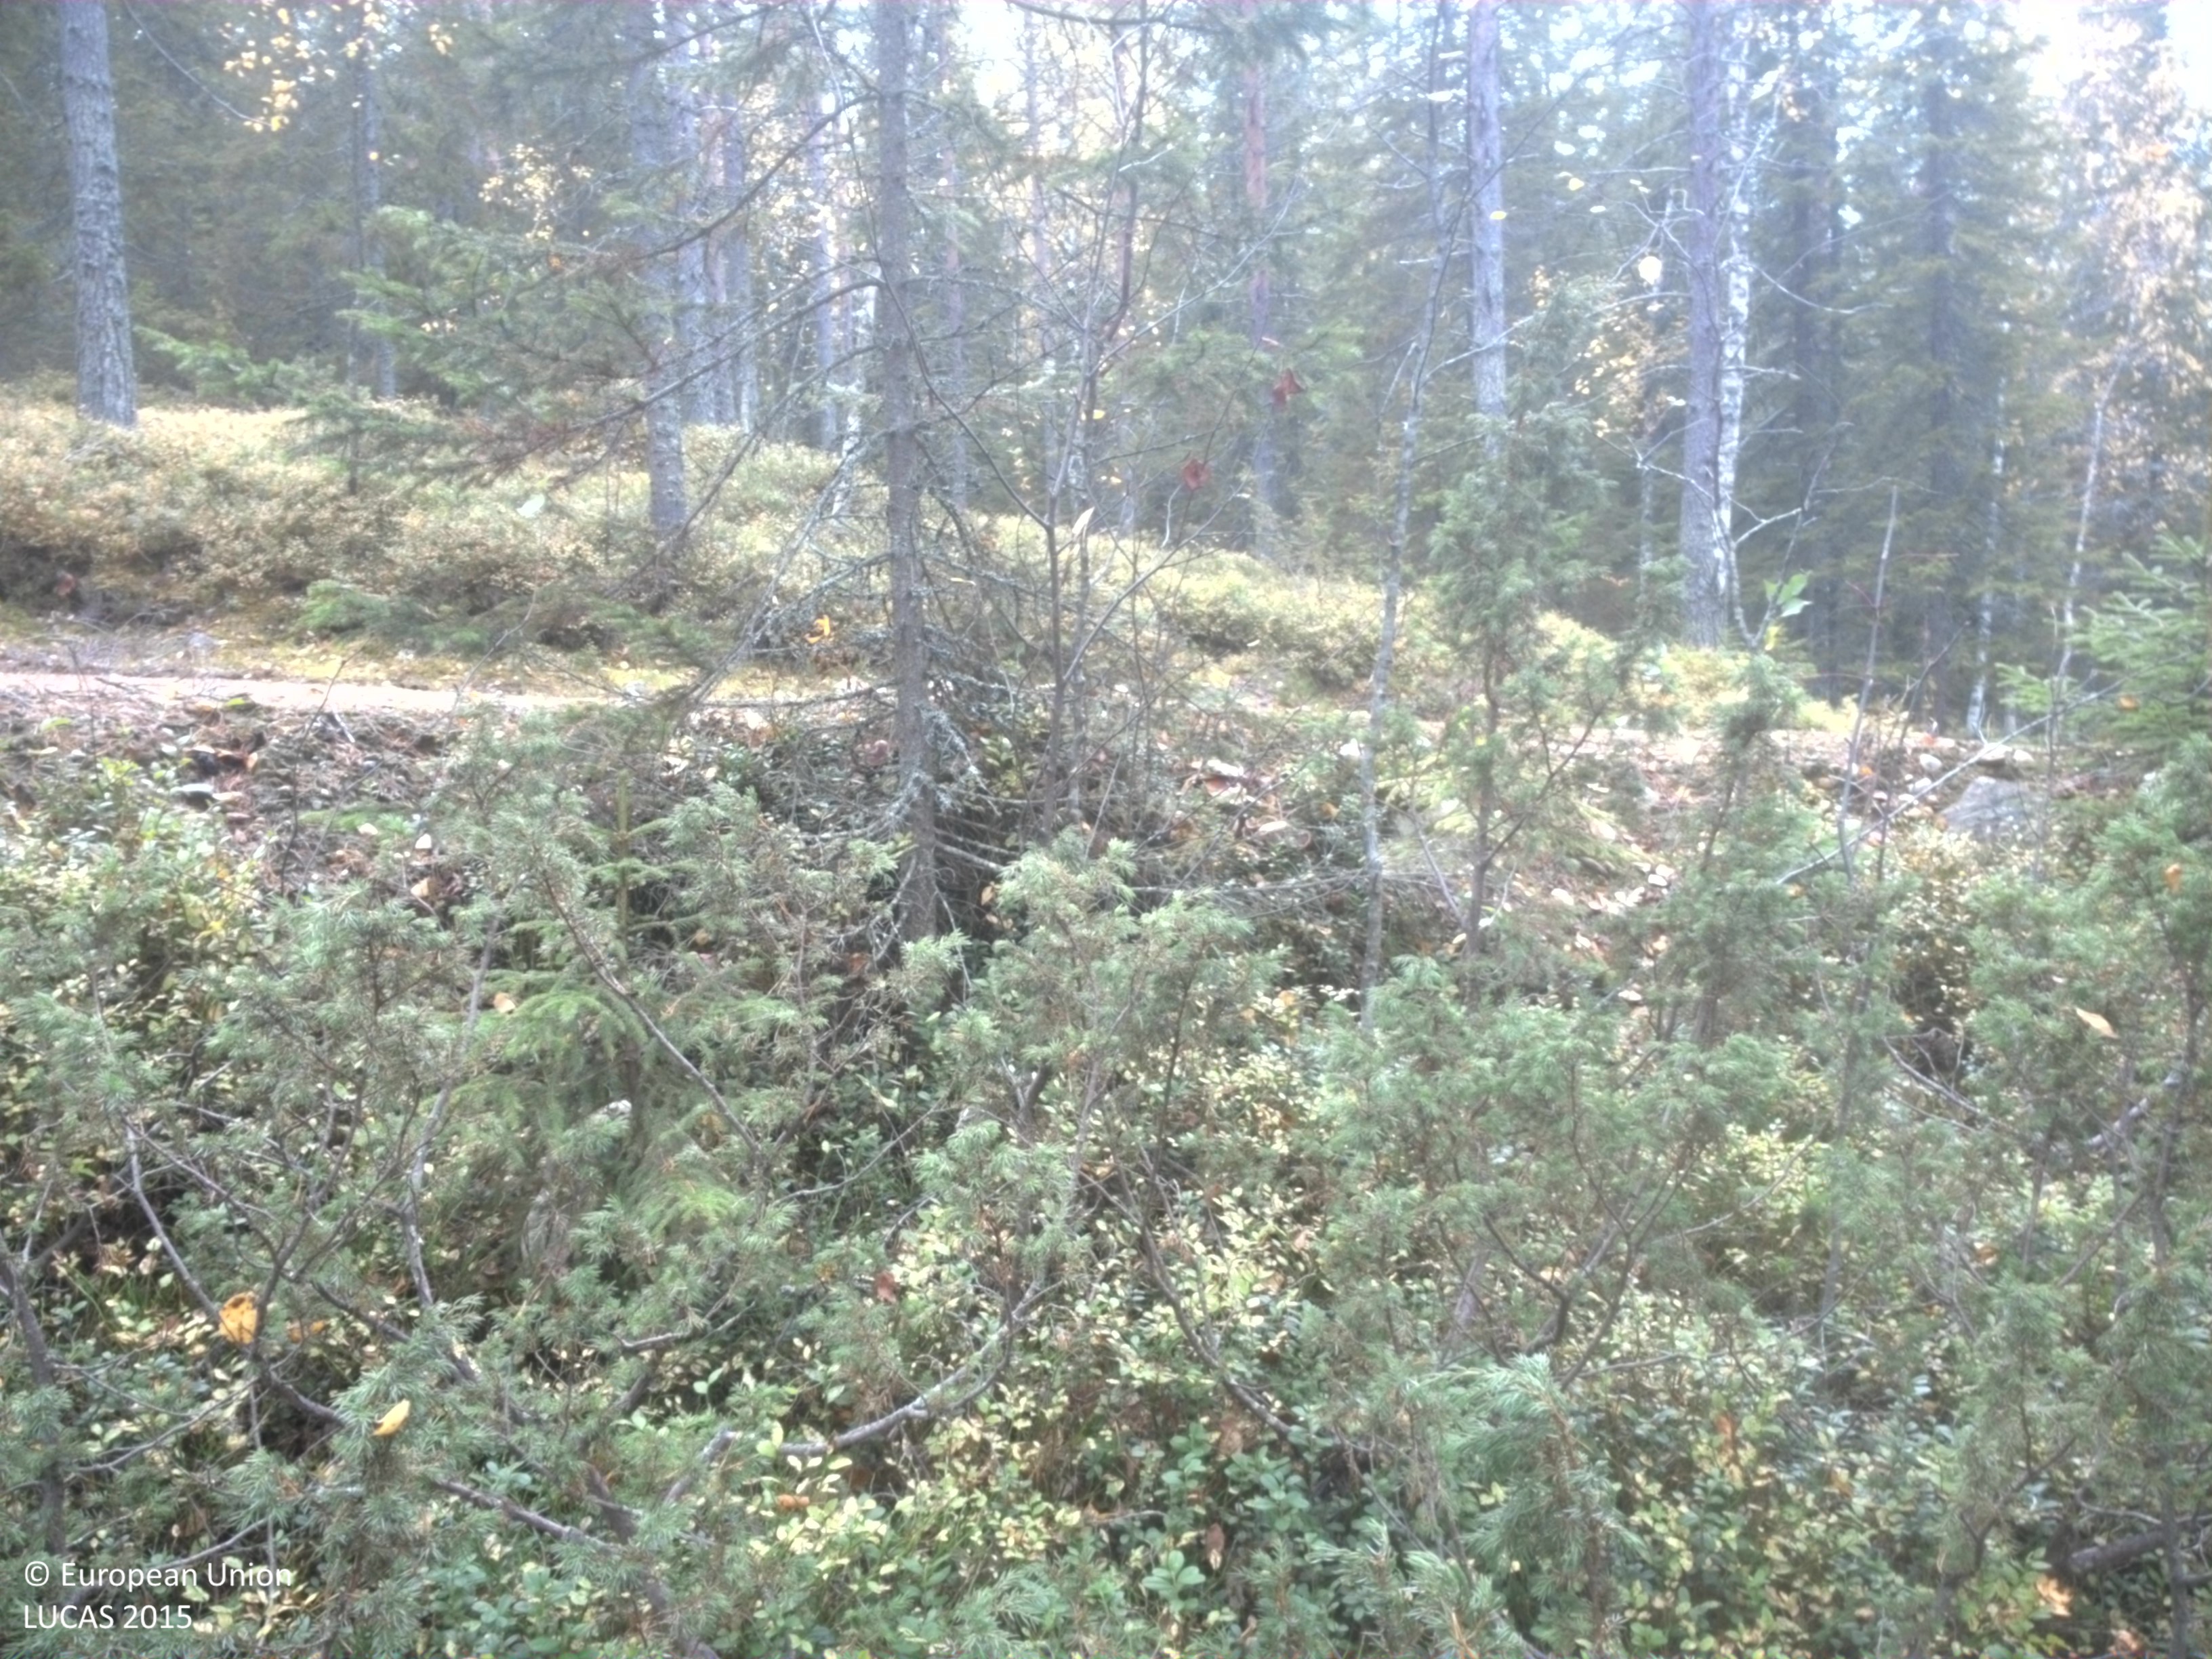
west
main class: Woodland
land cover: Pine dominated coniferous woodland
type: boreal forest
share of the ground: 50 - 75 %
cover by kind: coniferous forest trees 50 %, shrubs 25 %, herbaceous plants 10 %, lichens and mosses 10 %, broadleaved forest trees 5 %
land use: Forestry
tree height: > 5 m
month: September
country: SE
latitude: 64.3055
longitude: 20.2096
